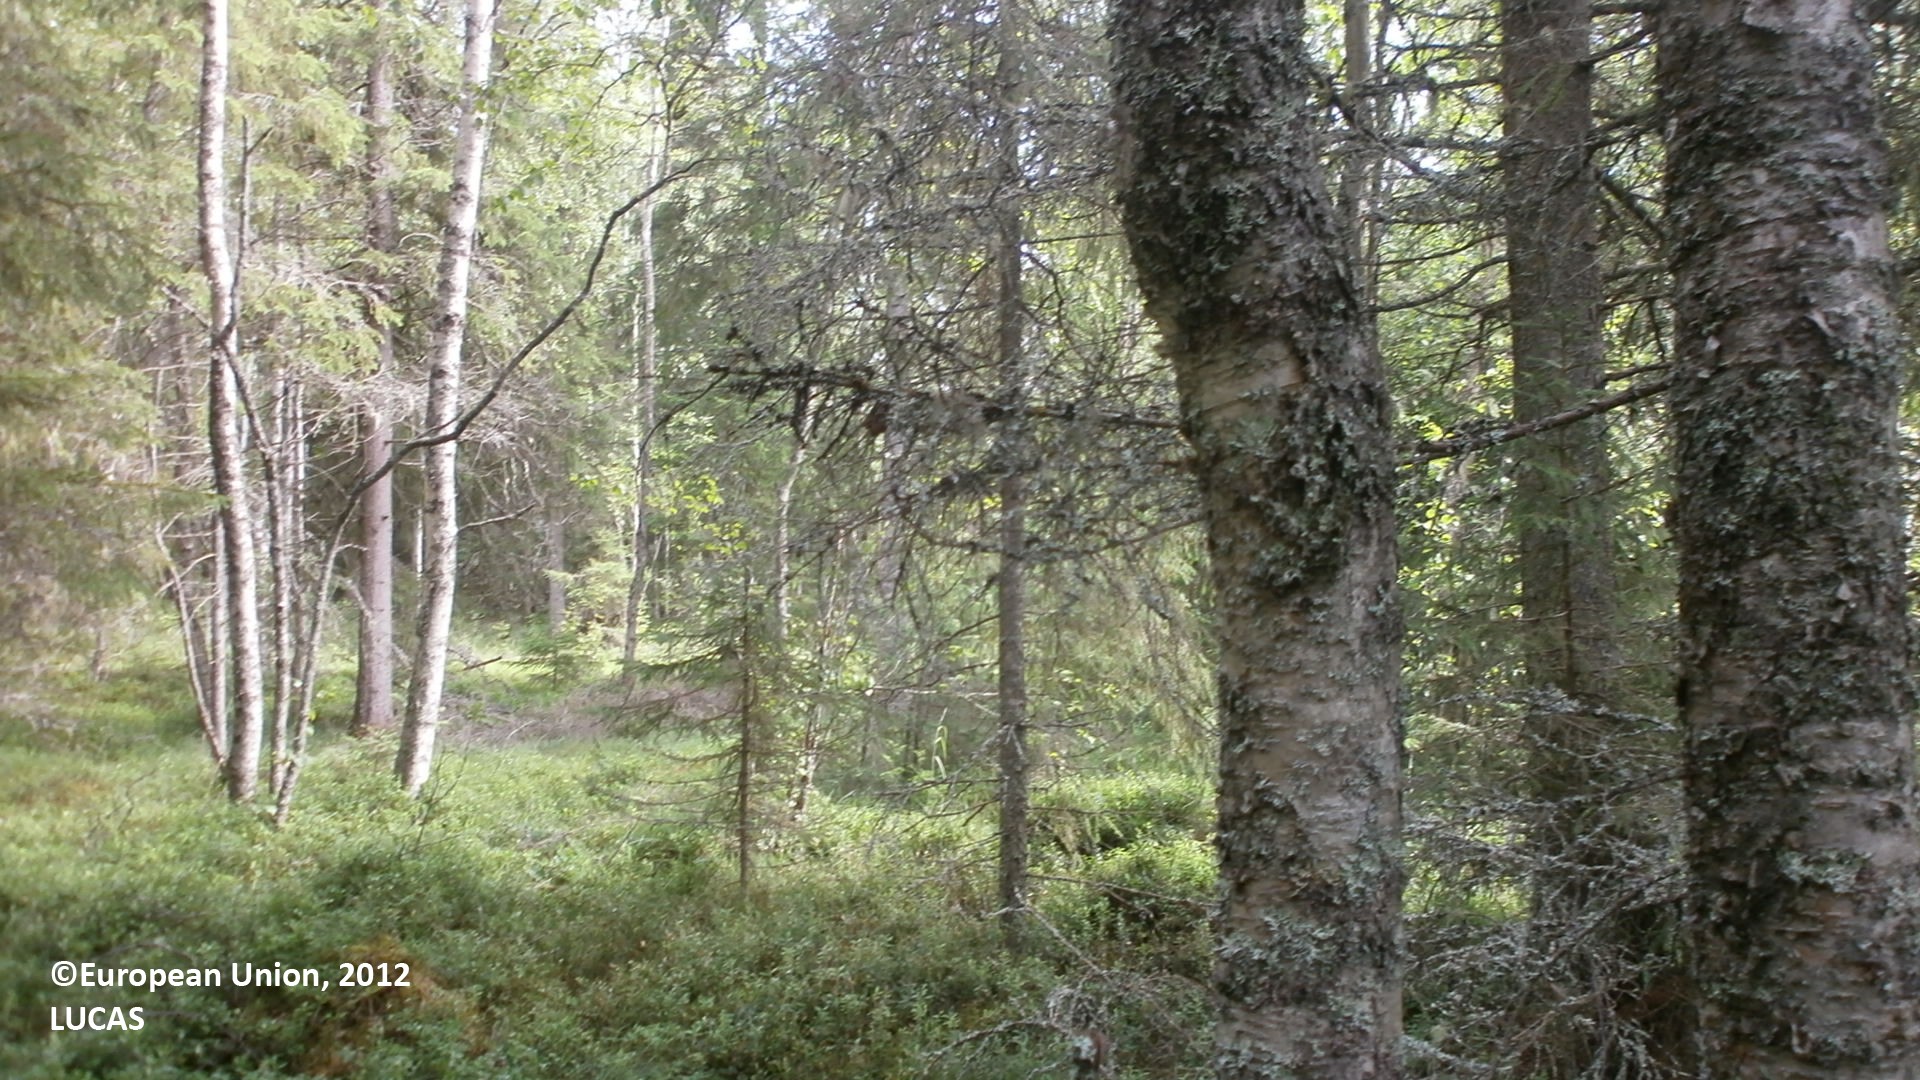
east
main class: Woodland
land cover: Spruce dominated mixed woodland
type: boreal forest
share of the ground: > 75 %
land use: Forestry
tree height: > 5 m
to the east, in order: Spruce dominated mixed woodland; Tracks; Spruce dominated mixed woodland; Ditches and canals; Shruby margins; Tracks; Shruby margins; Spruce dominated mixed woodland; Ditches and canals; Spruce dominated mixed woodland
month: July
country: FI
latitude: 64.5305
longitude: 24.3849
